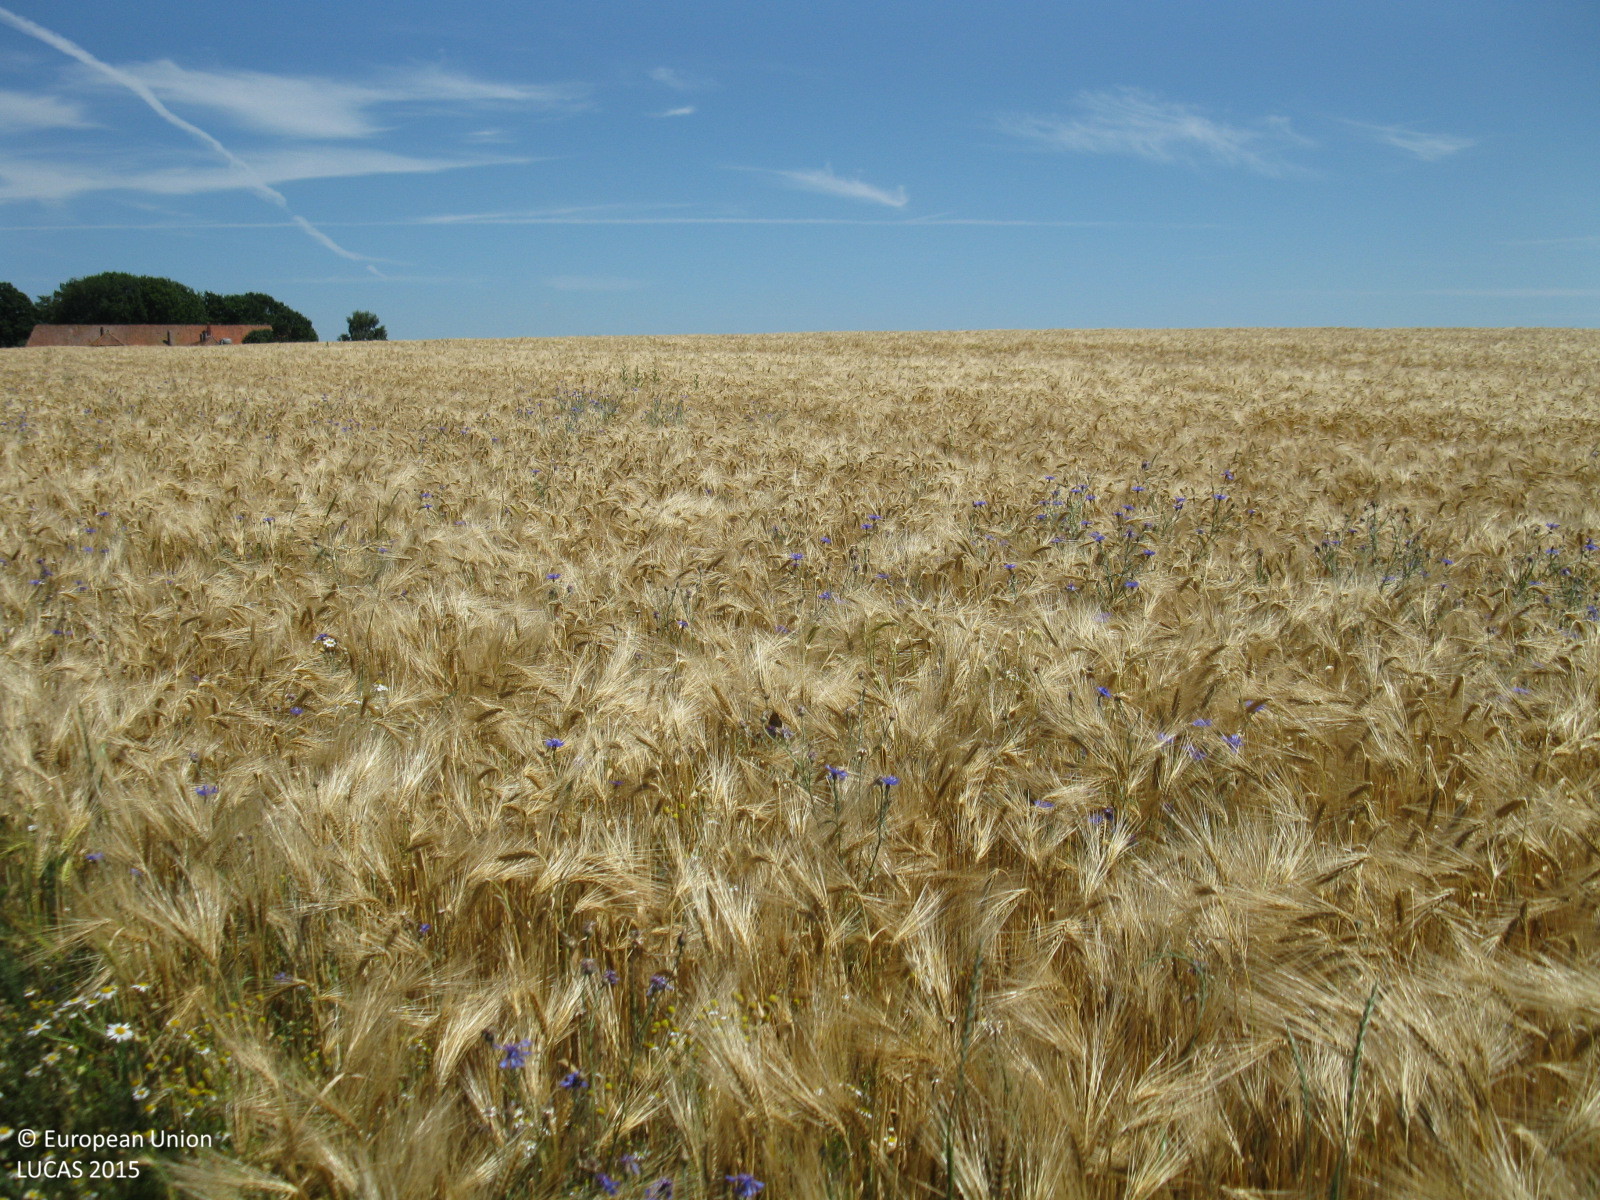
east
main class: Cropland
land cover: Barley
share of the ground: > 75 %
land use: Agriculture (excluding fallow land and kitchen gardens)
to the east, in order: Barley; Grass margins; Tracks; Grass margins; Maize
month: June
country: DE
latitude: 52.8904
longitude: 8.5885
